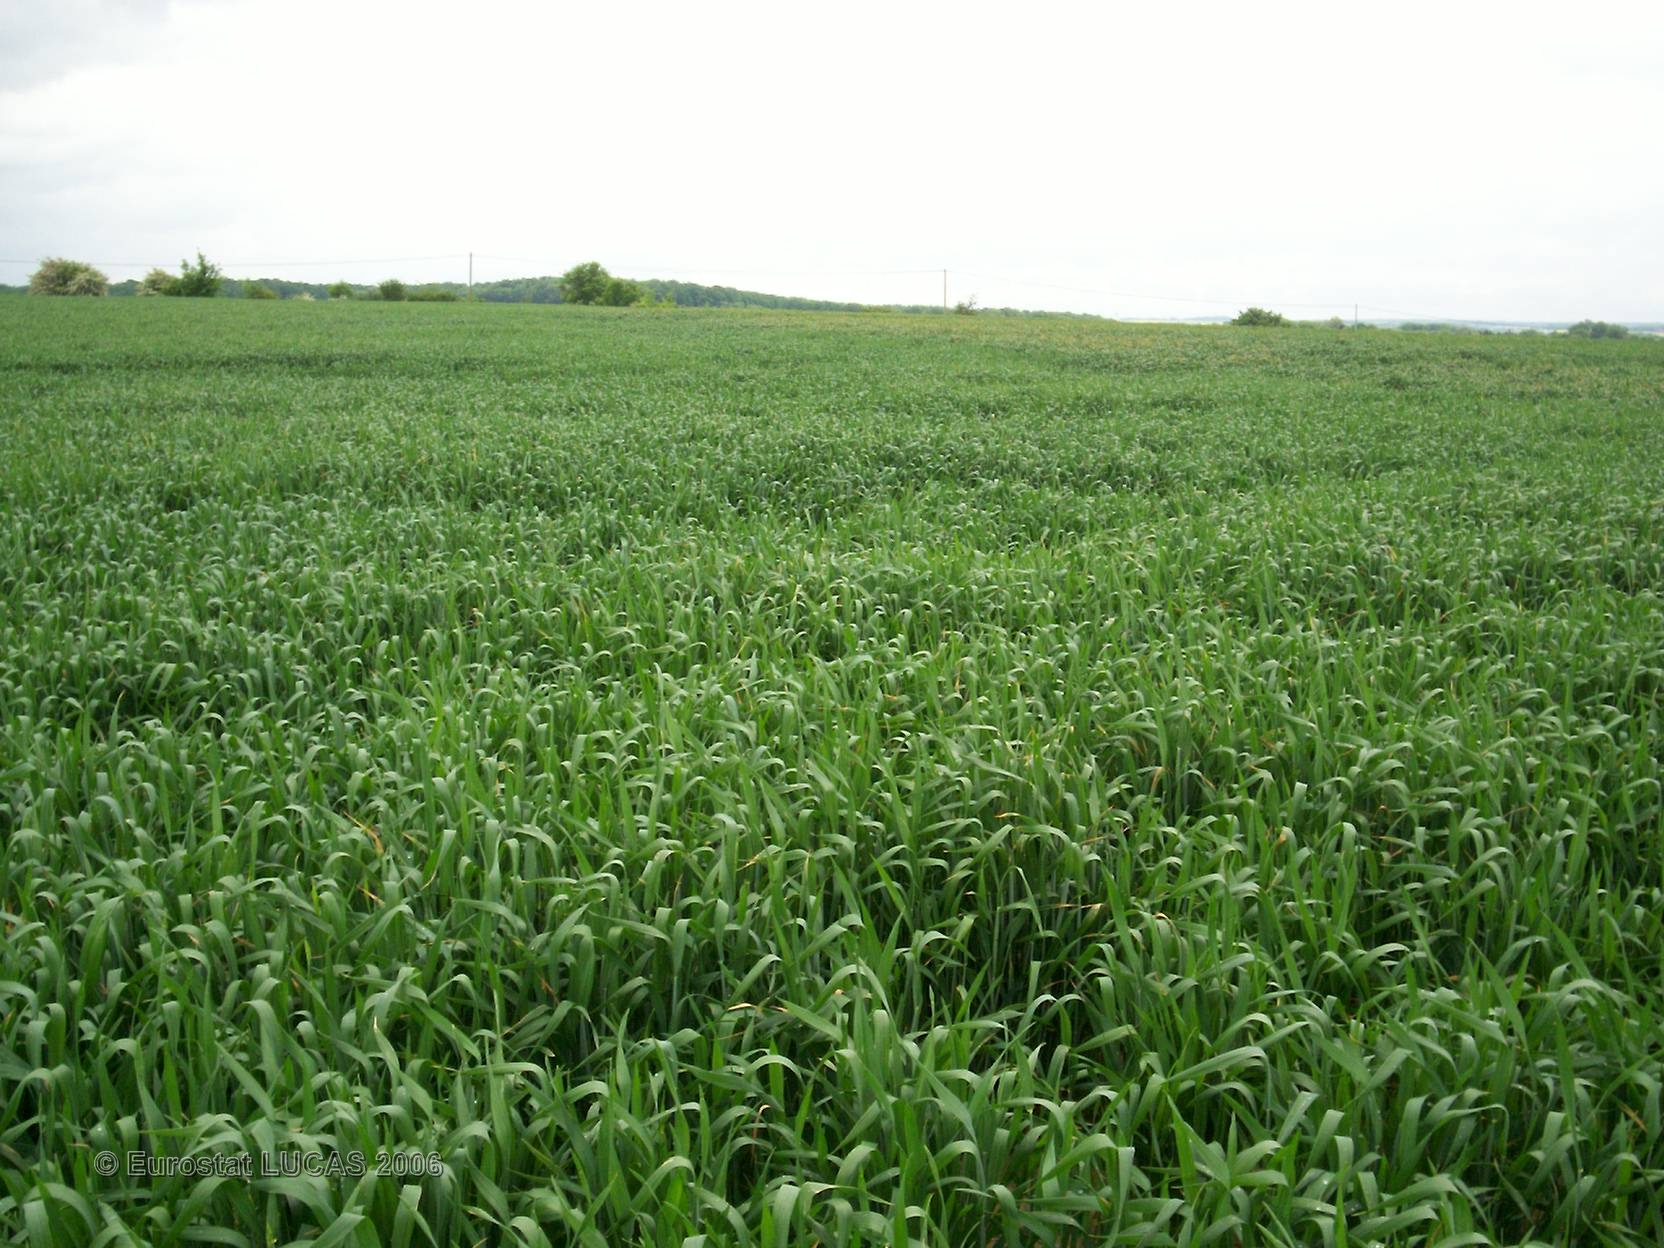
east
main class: Cropland
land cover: Common wheat
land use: Agriculture (excluding fallow land and kitchen gardens)
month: May
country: FR
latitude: 48.2467
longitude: 4.4627
